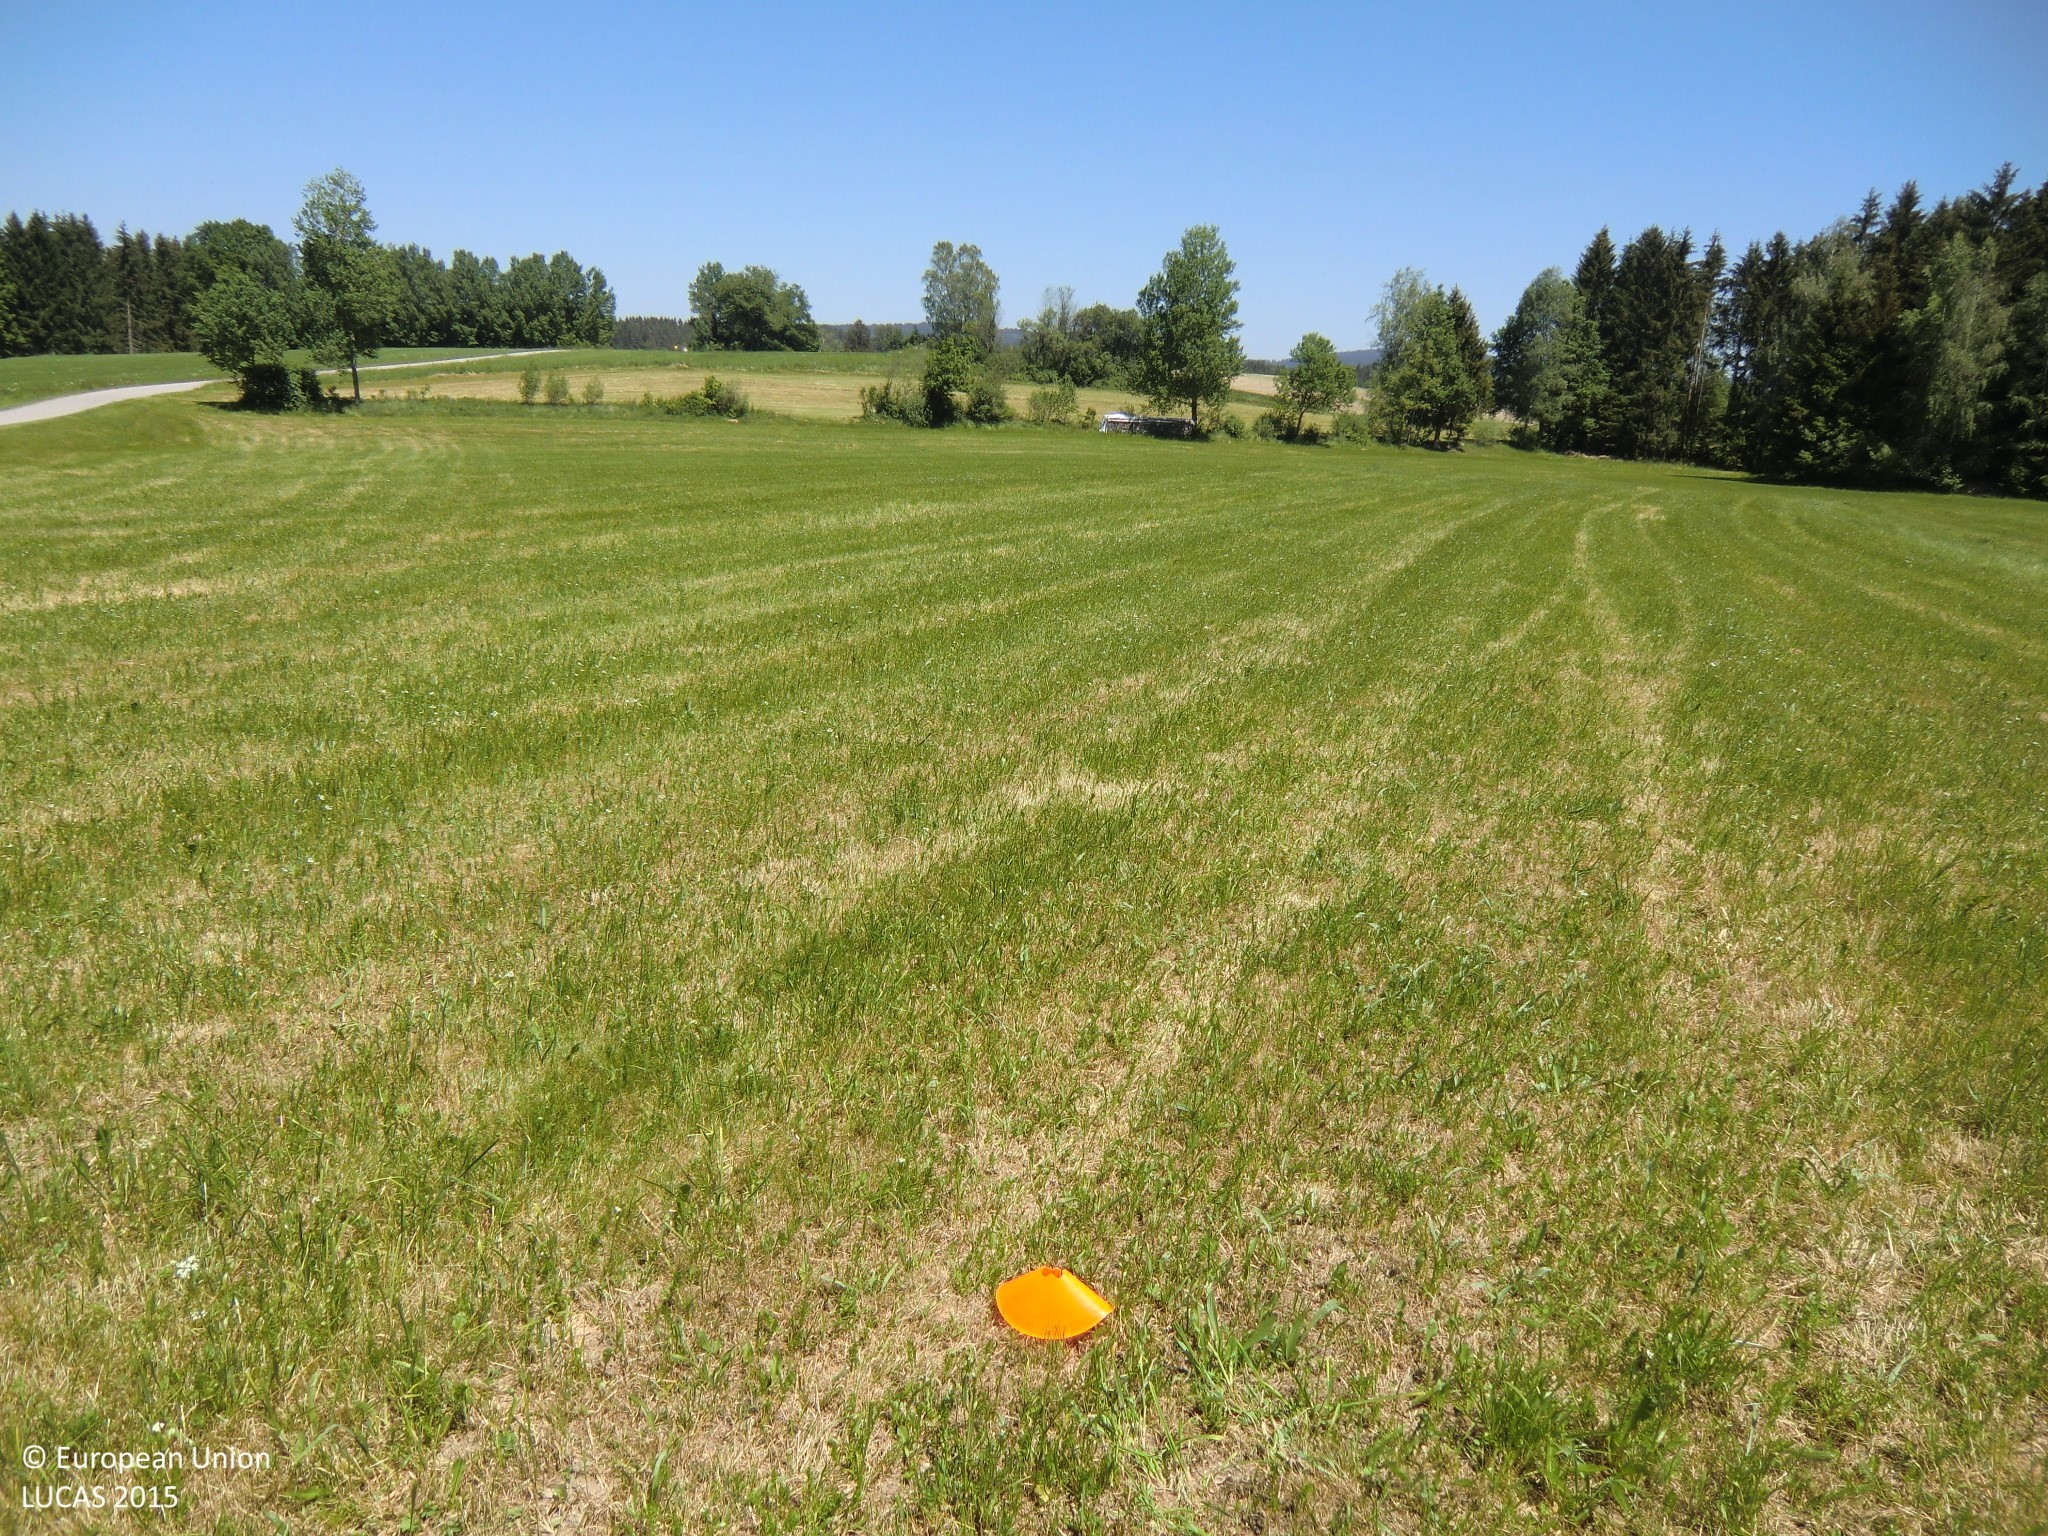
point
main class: Grassland
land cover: Grassland without tree/shrub cover
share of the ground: > 75 %
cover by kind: herbaceous plants 100 %
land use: Agriculture (excluding fallow land and kitchen gardens)
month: June
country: AT
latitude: 48.6377
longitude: 14.4655
